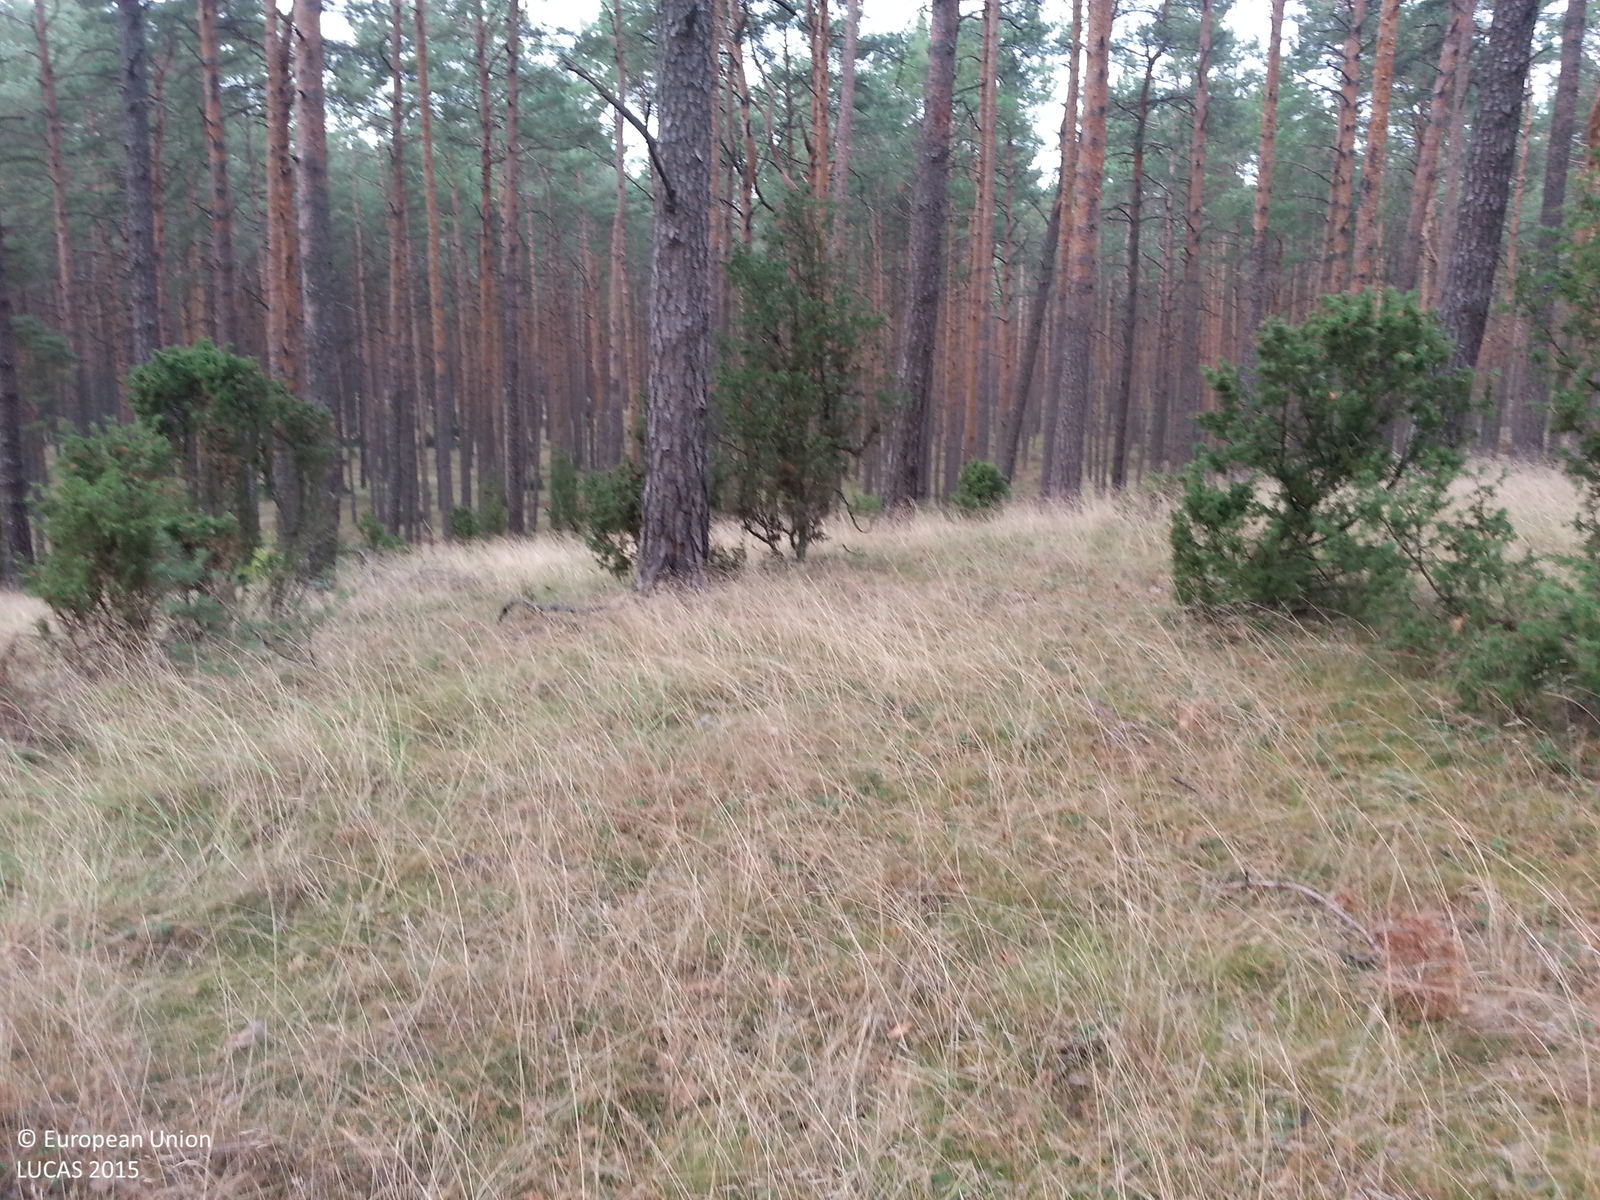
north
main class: Woodland
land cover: Pine dominated coniferous woodland
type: hemiboreal forest and nemoral coniferous forest and mixed broadleaved-coniferous forest
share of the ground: 50 - 75 %
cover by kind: coniferous forest trees 70 %, herbaceous plants 20 %, lichens and mosses 10 %
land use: Forestry
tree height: > 5 m
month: September
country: PL
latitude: 53.0034
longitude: 18.1076
